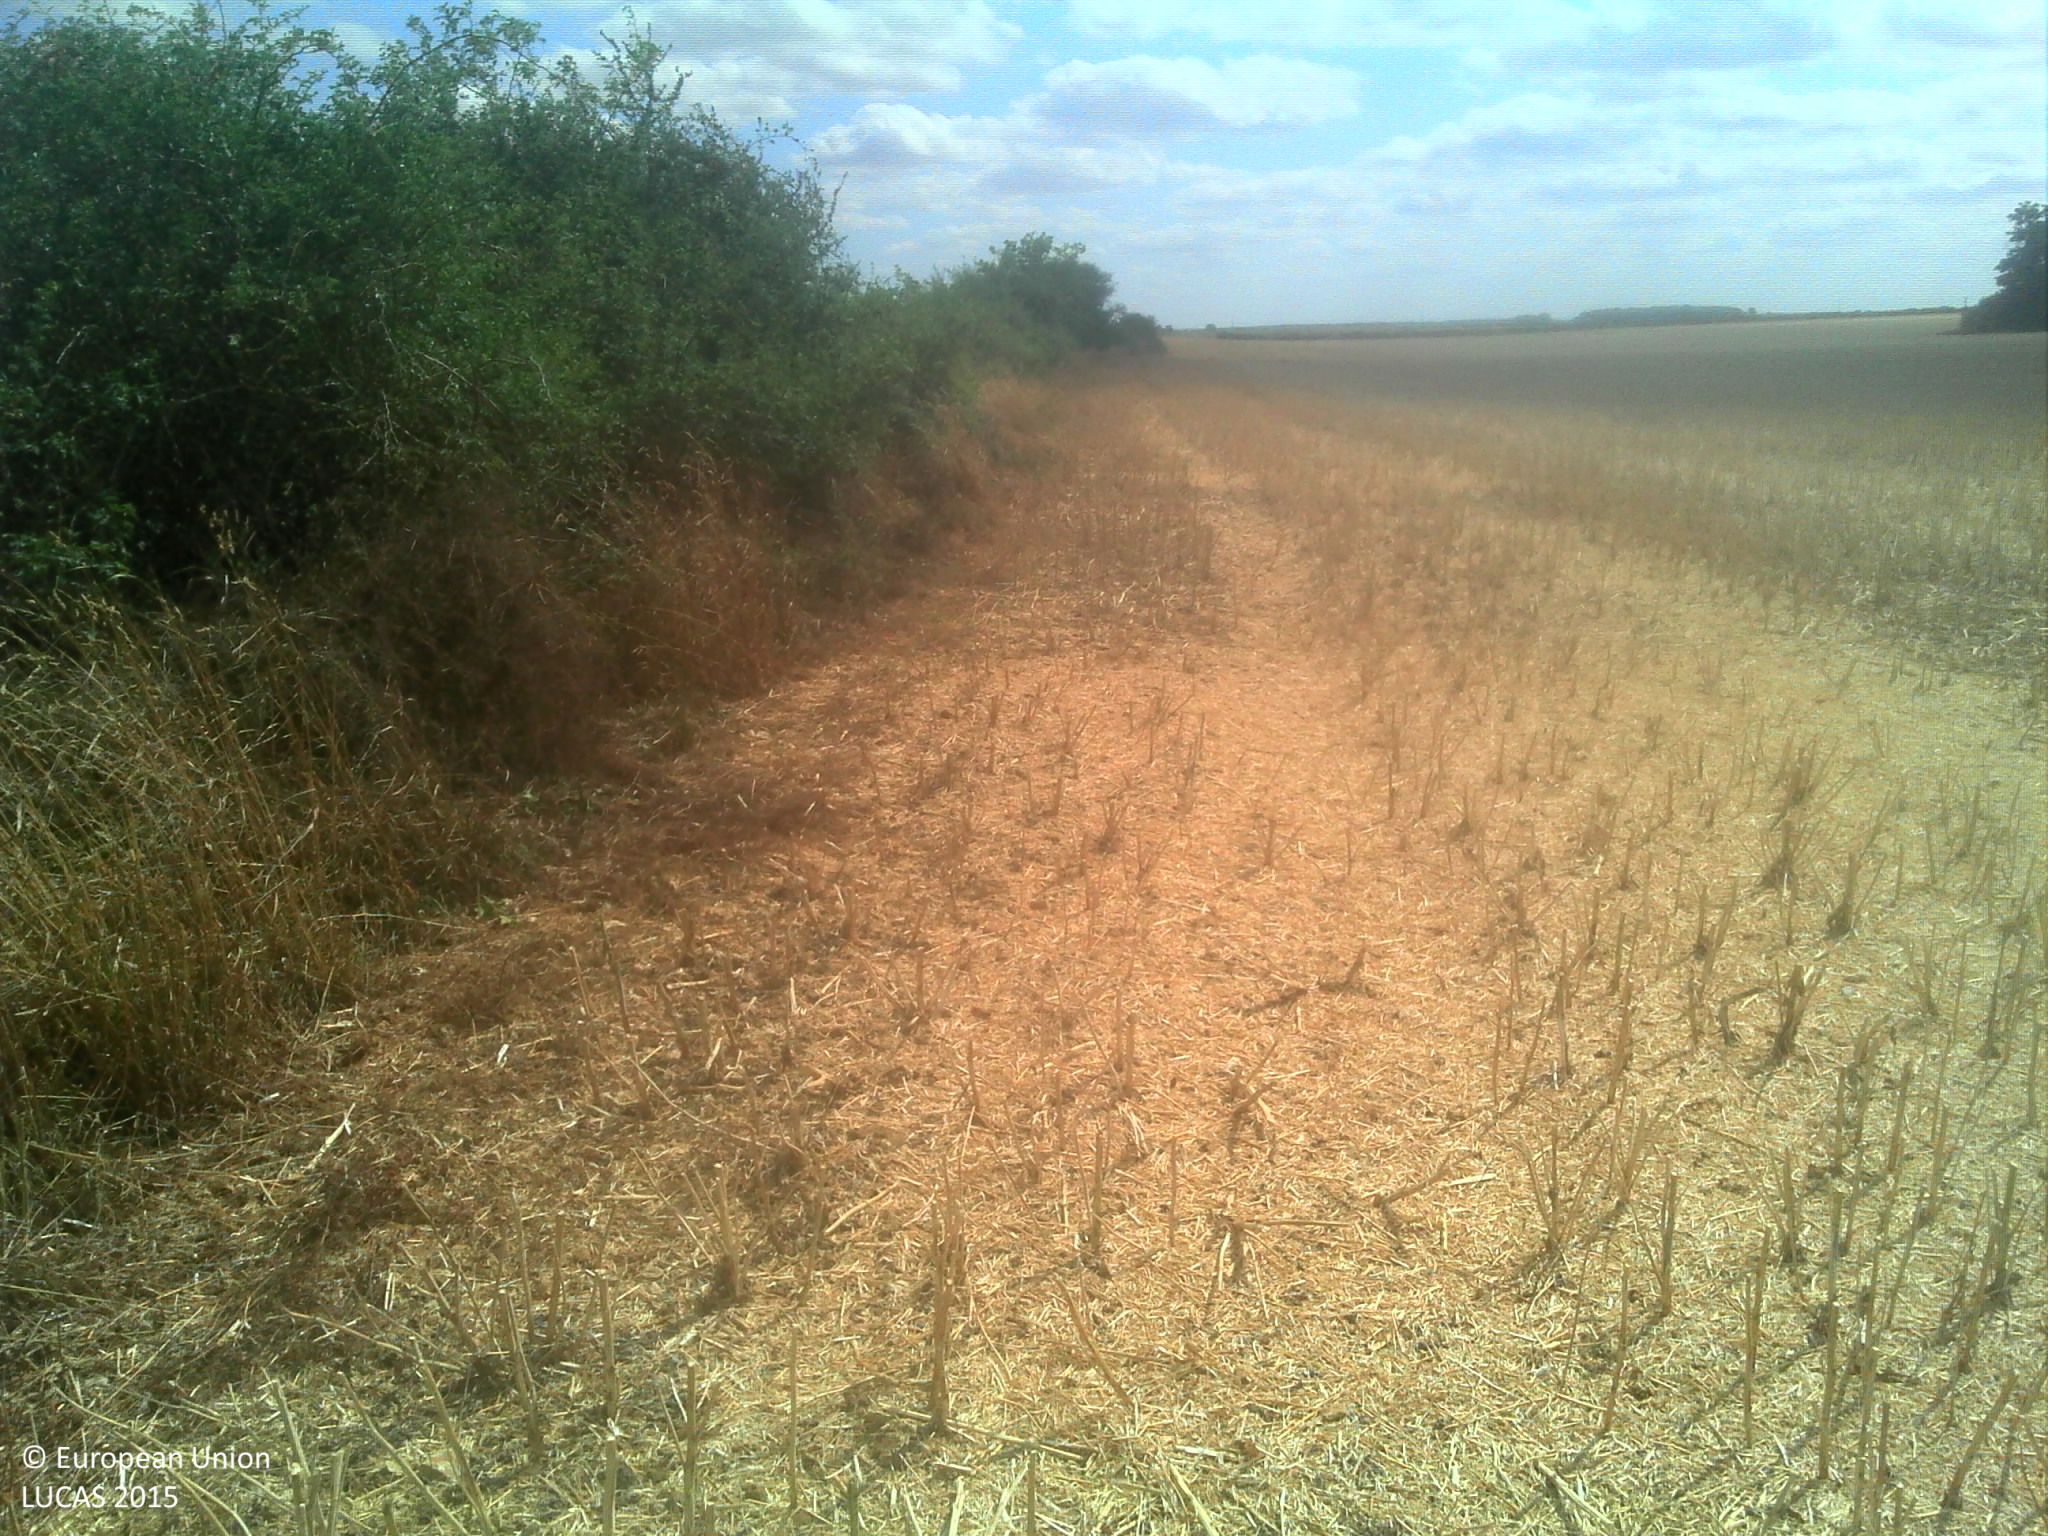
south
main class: Cropland
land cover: Rape and turnip rape
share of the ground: > 75 %
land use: Agriculture (excluding fallow land and kitchen gardens)
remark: Harvested field
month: July
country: FR
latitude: 47.9530
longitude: 1.3197
